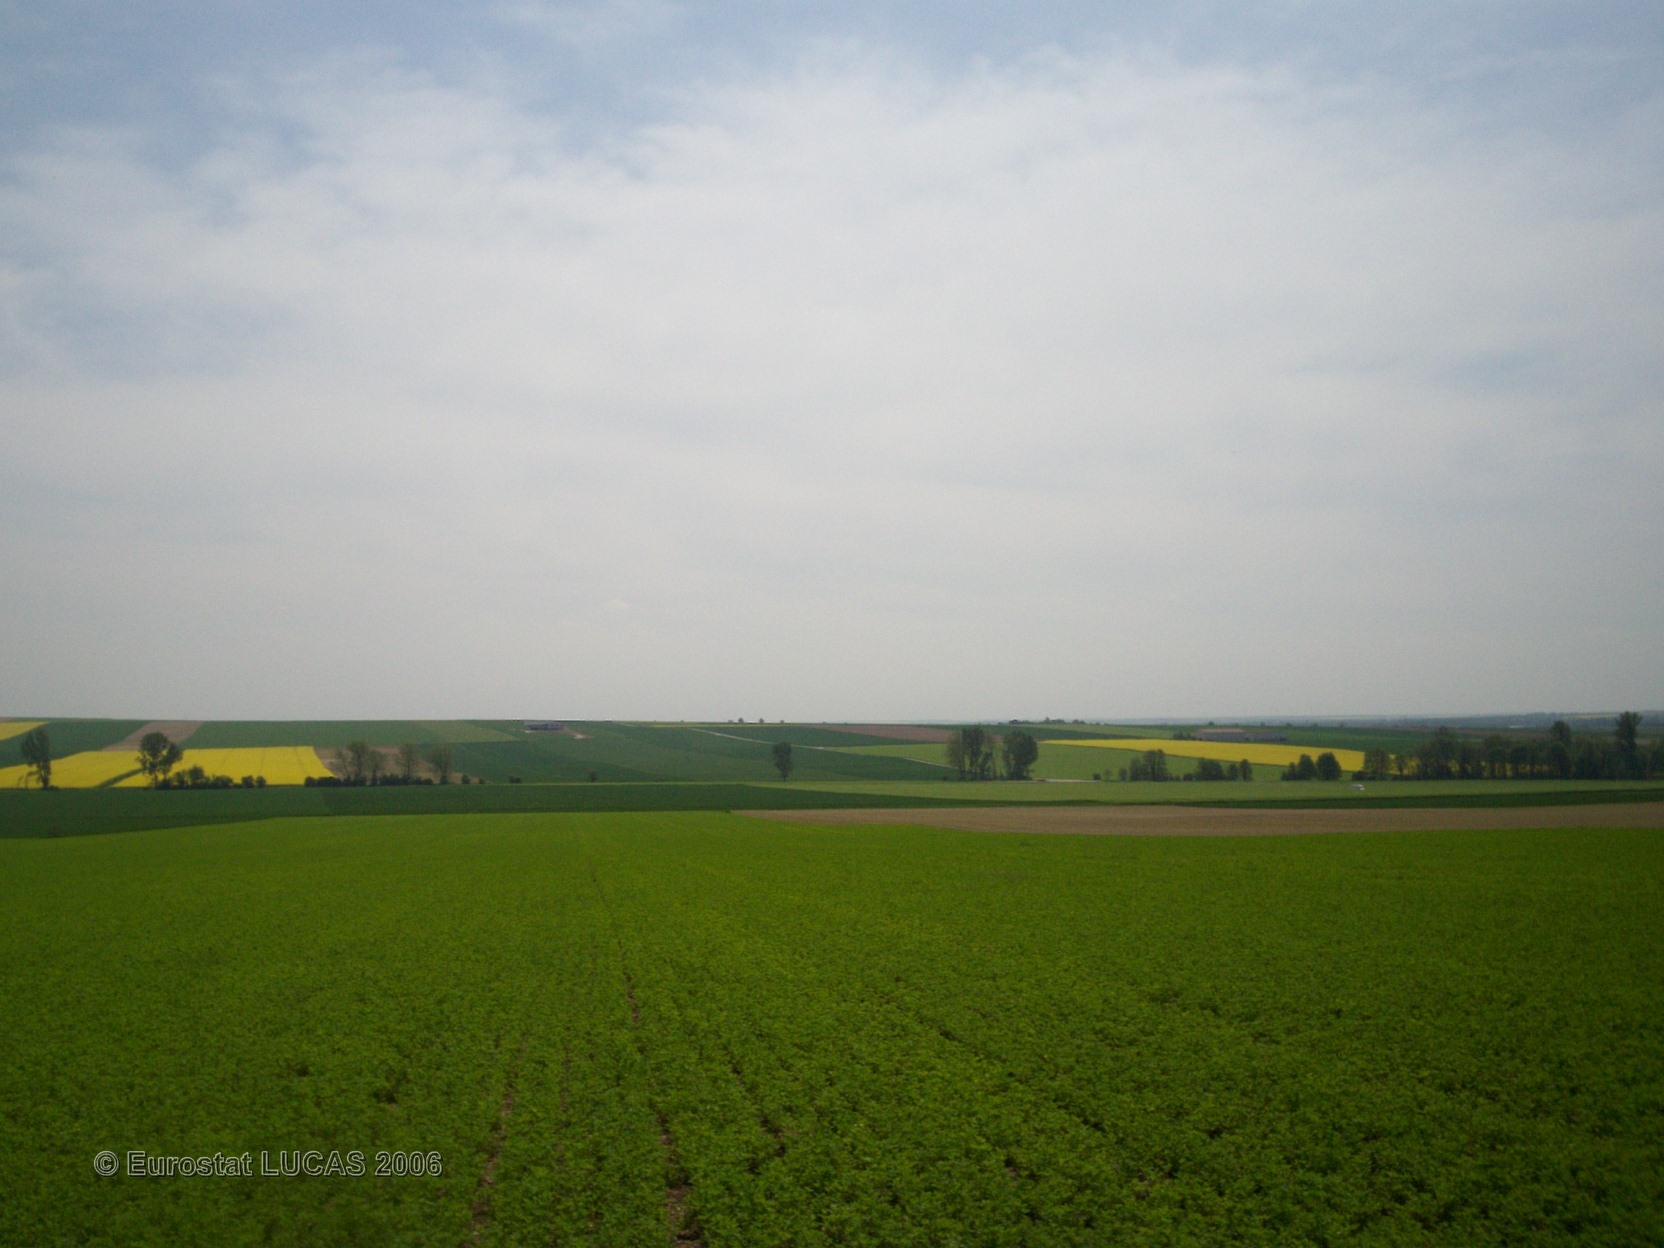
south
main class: Cropland
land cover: Lucerne
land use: Agriculture (excluding fallow land and kitchen gardens)
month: May
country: FR
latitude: 48.9654
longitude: 4.4098
